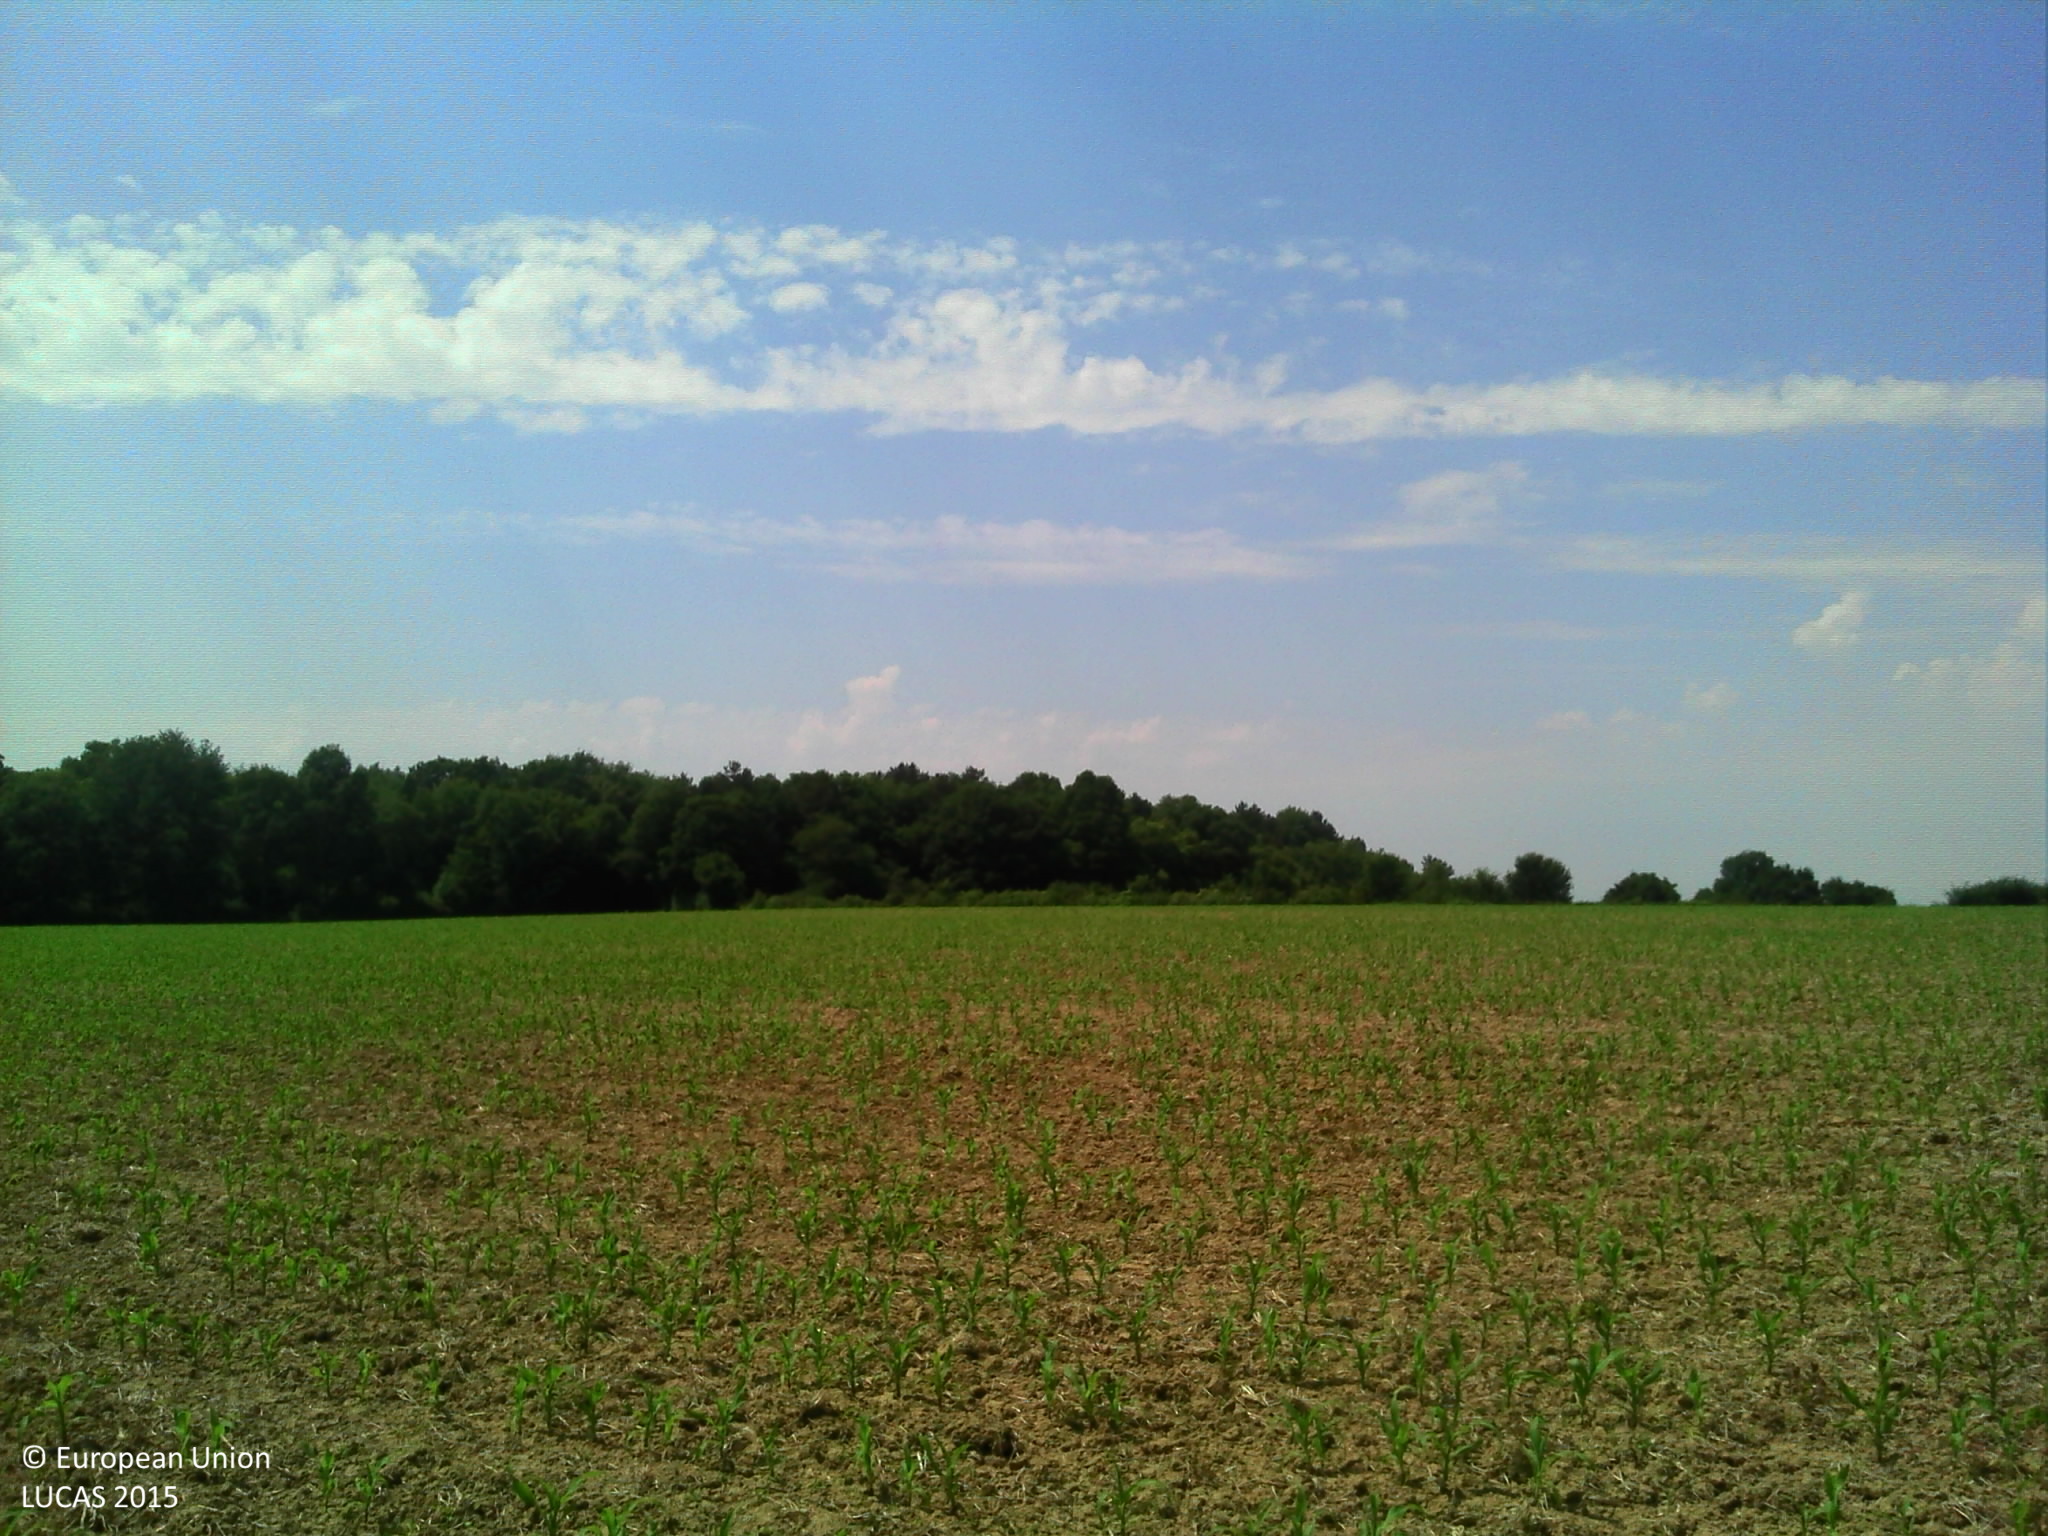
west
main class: Cropland
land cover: Maize
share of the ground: 25 - 50 %
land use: Agriculture (excluding fallow land and kitchen gardens)
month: June
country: FR
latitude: 47.9512
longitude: 0.0237
